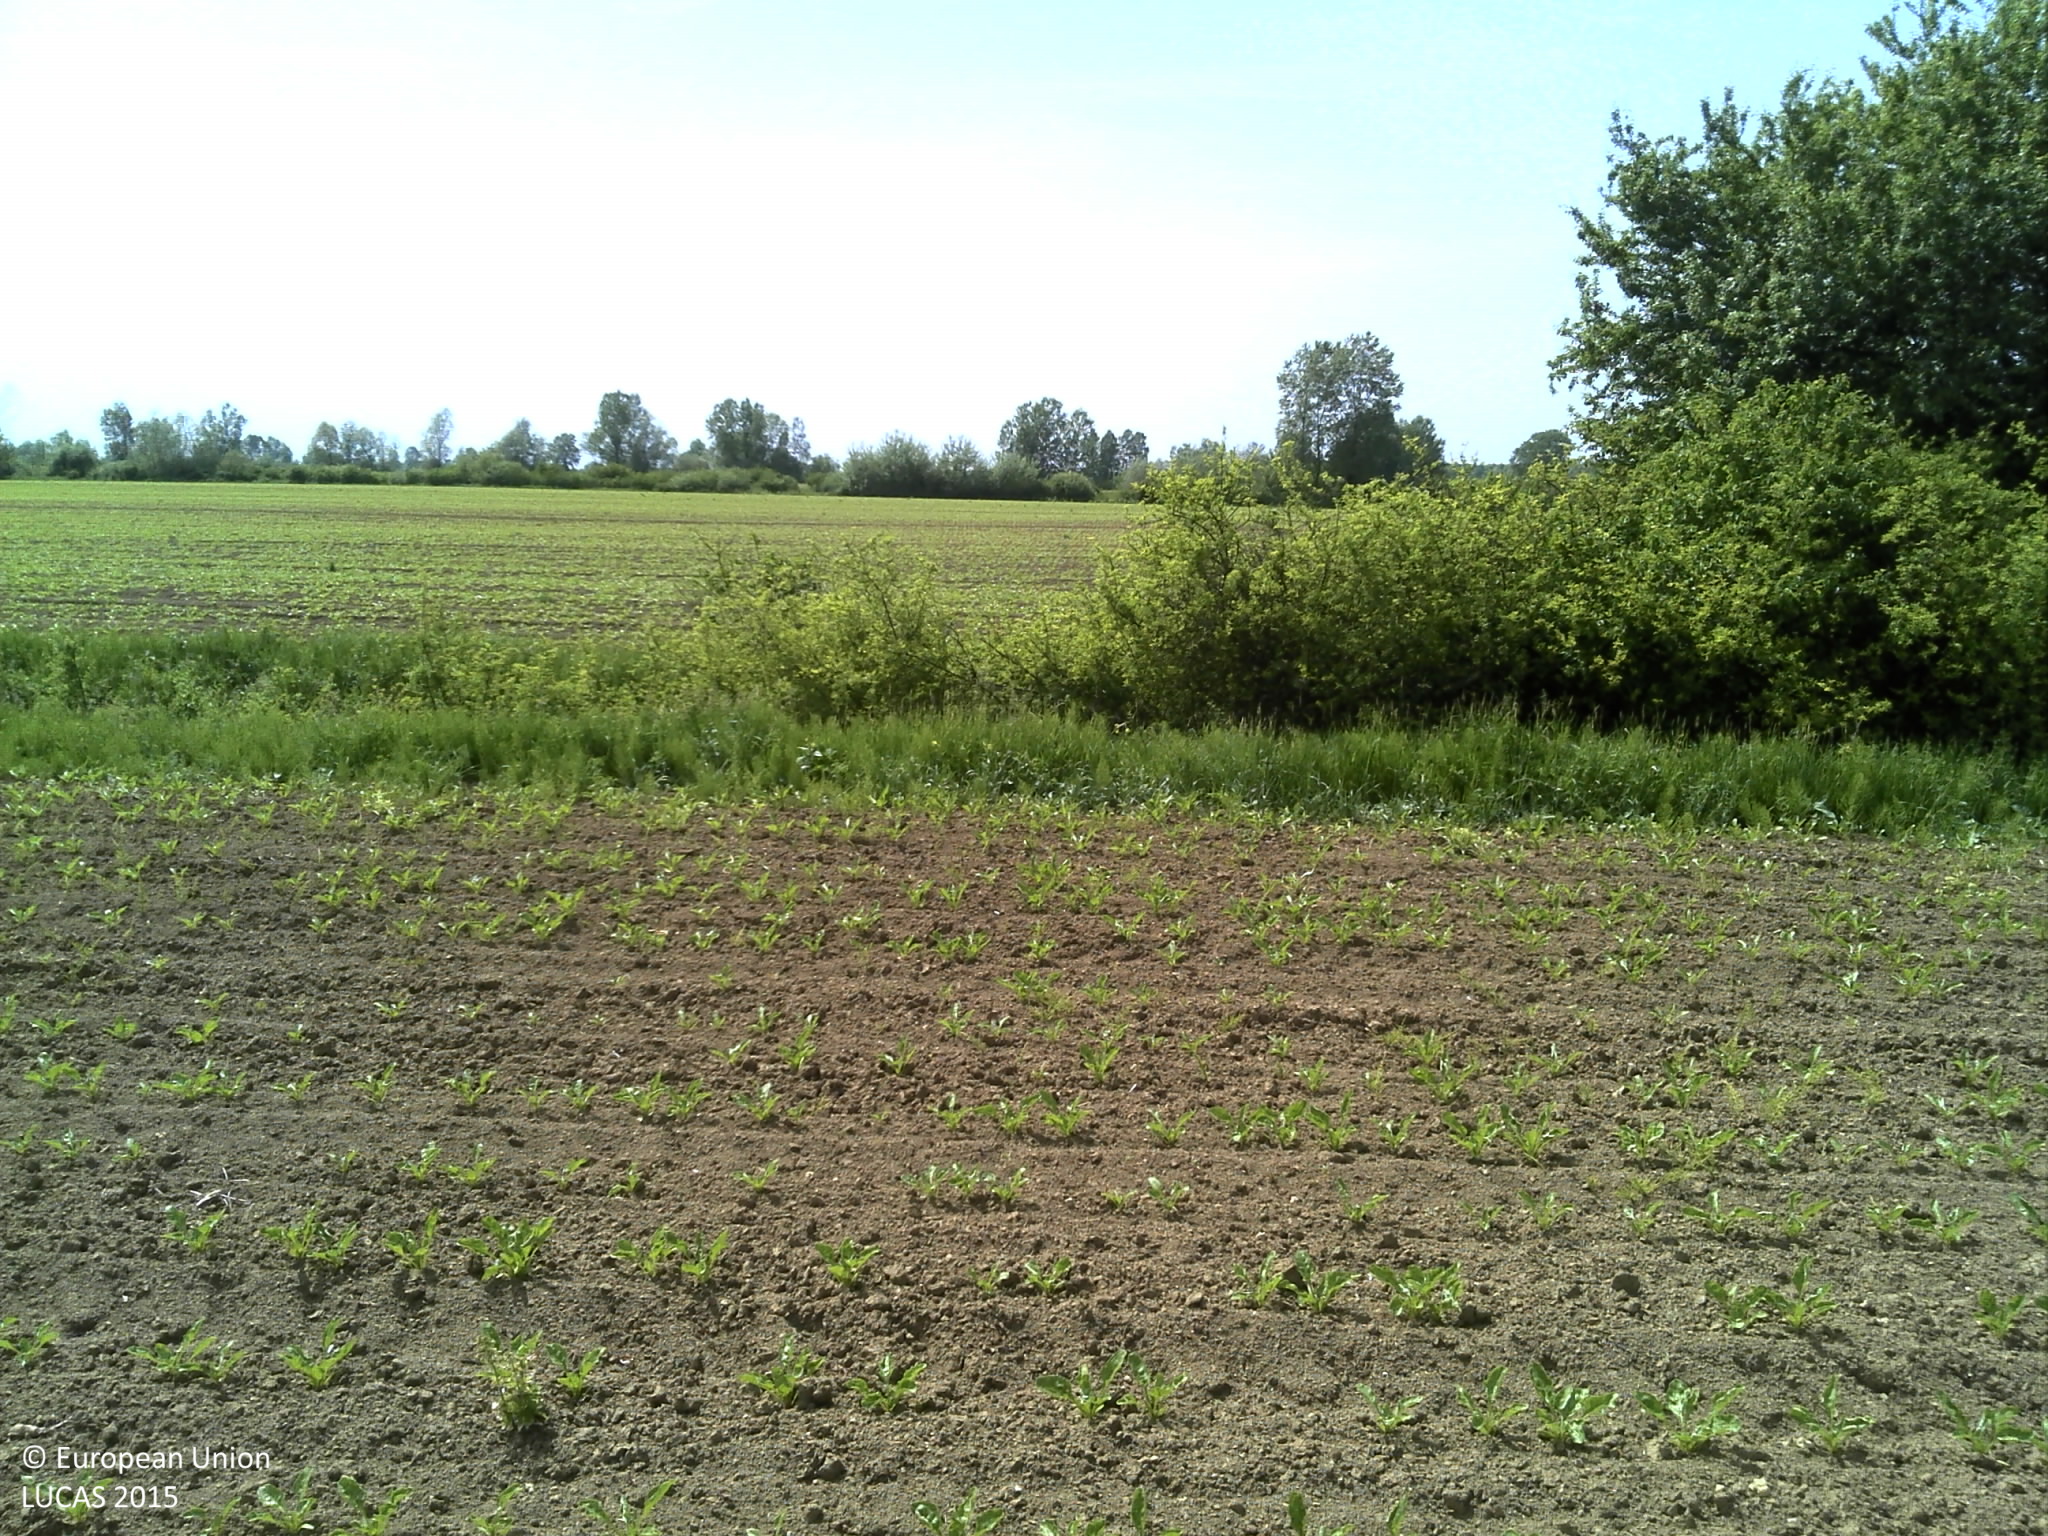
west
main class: Cropland
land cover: Sugar beet
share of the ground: < 10 %
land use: Agriculture (excluding fallow land and kitchen gardens)
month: May
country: HR
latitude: 45.1977
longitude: 18.4958
